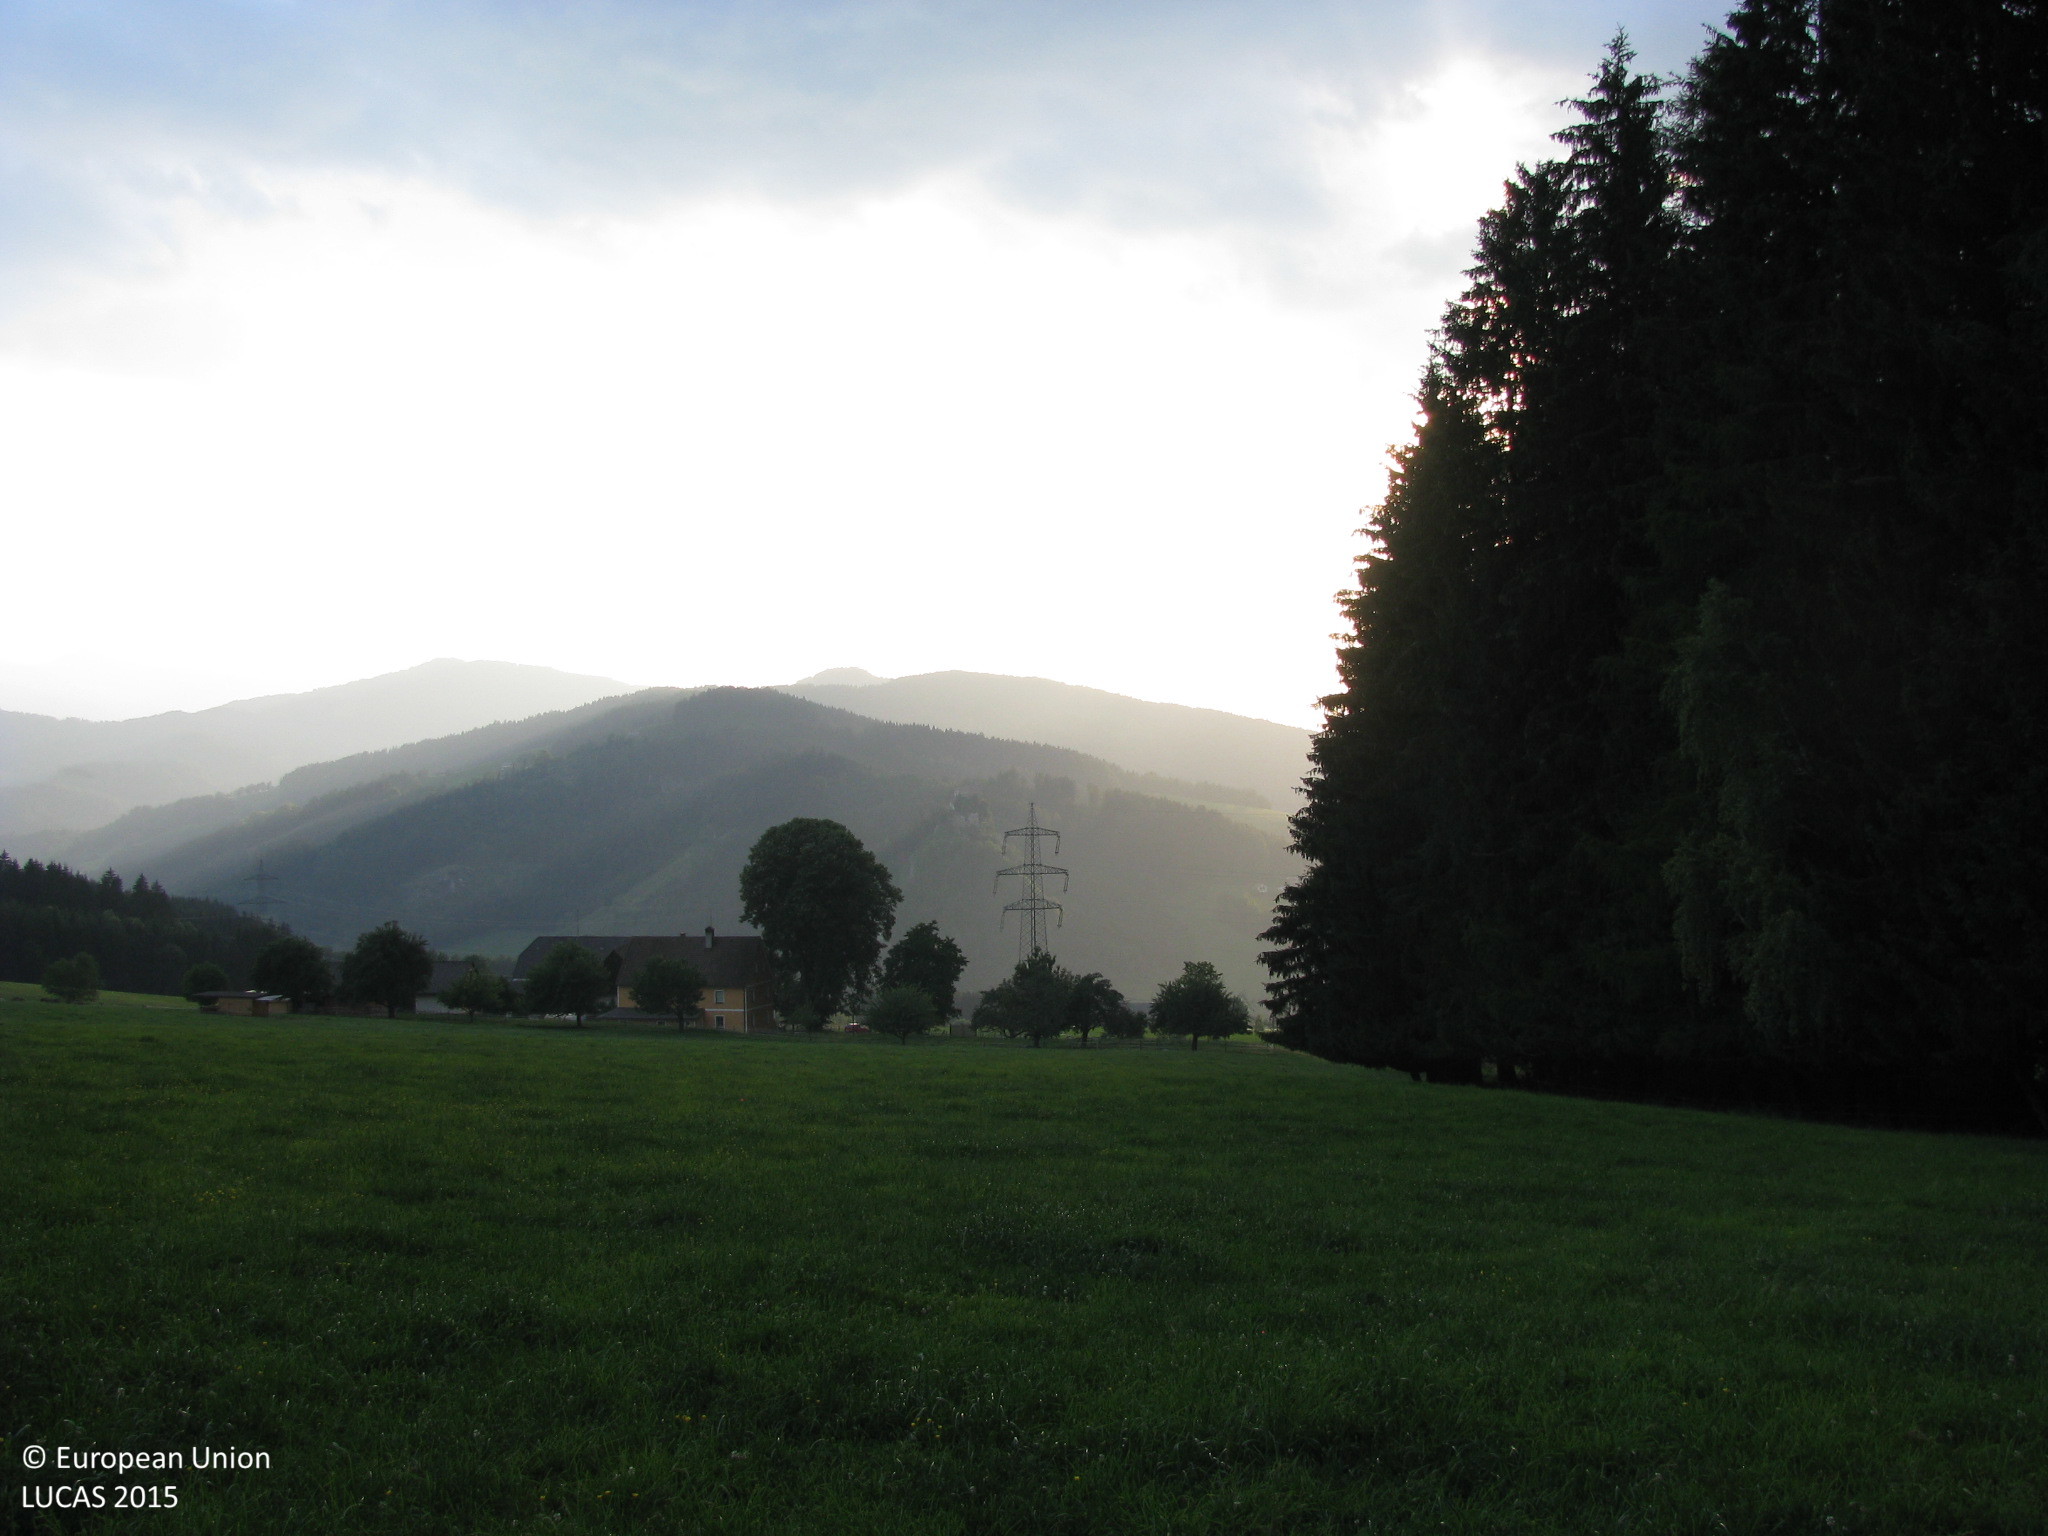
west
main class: Grassland
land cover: Grassland without tree/shrub cover
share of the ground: > 75 %
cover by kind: herbaceous plants 100 %
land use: Agriculture (excluding fallow land and kitchen gardens)
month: July
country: AT
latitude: 47.1292
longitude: 14.7579
